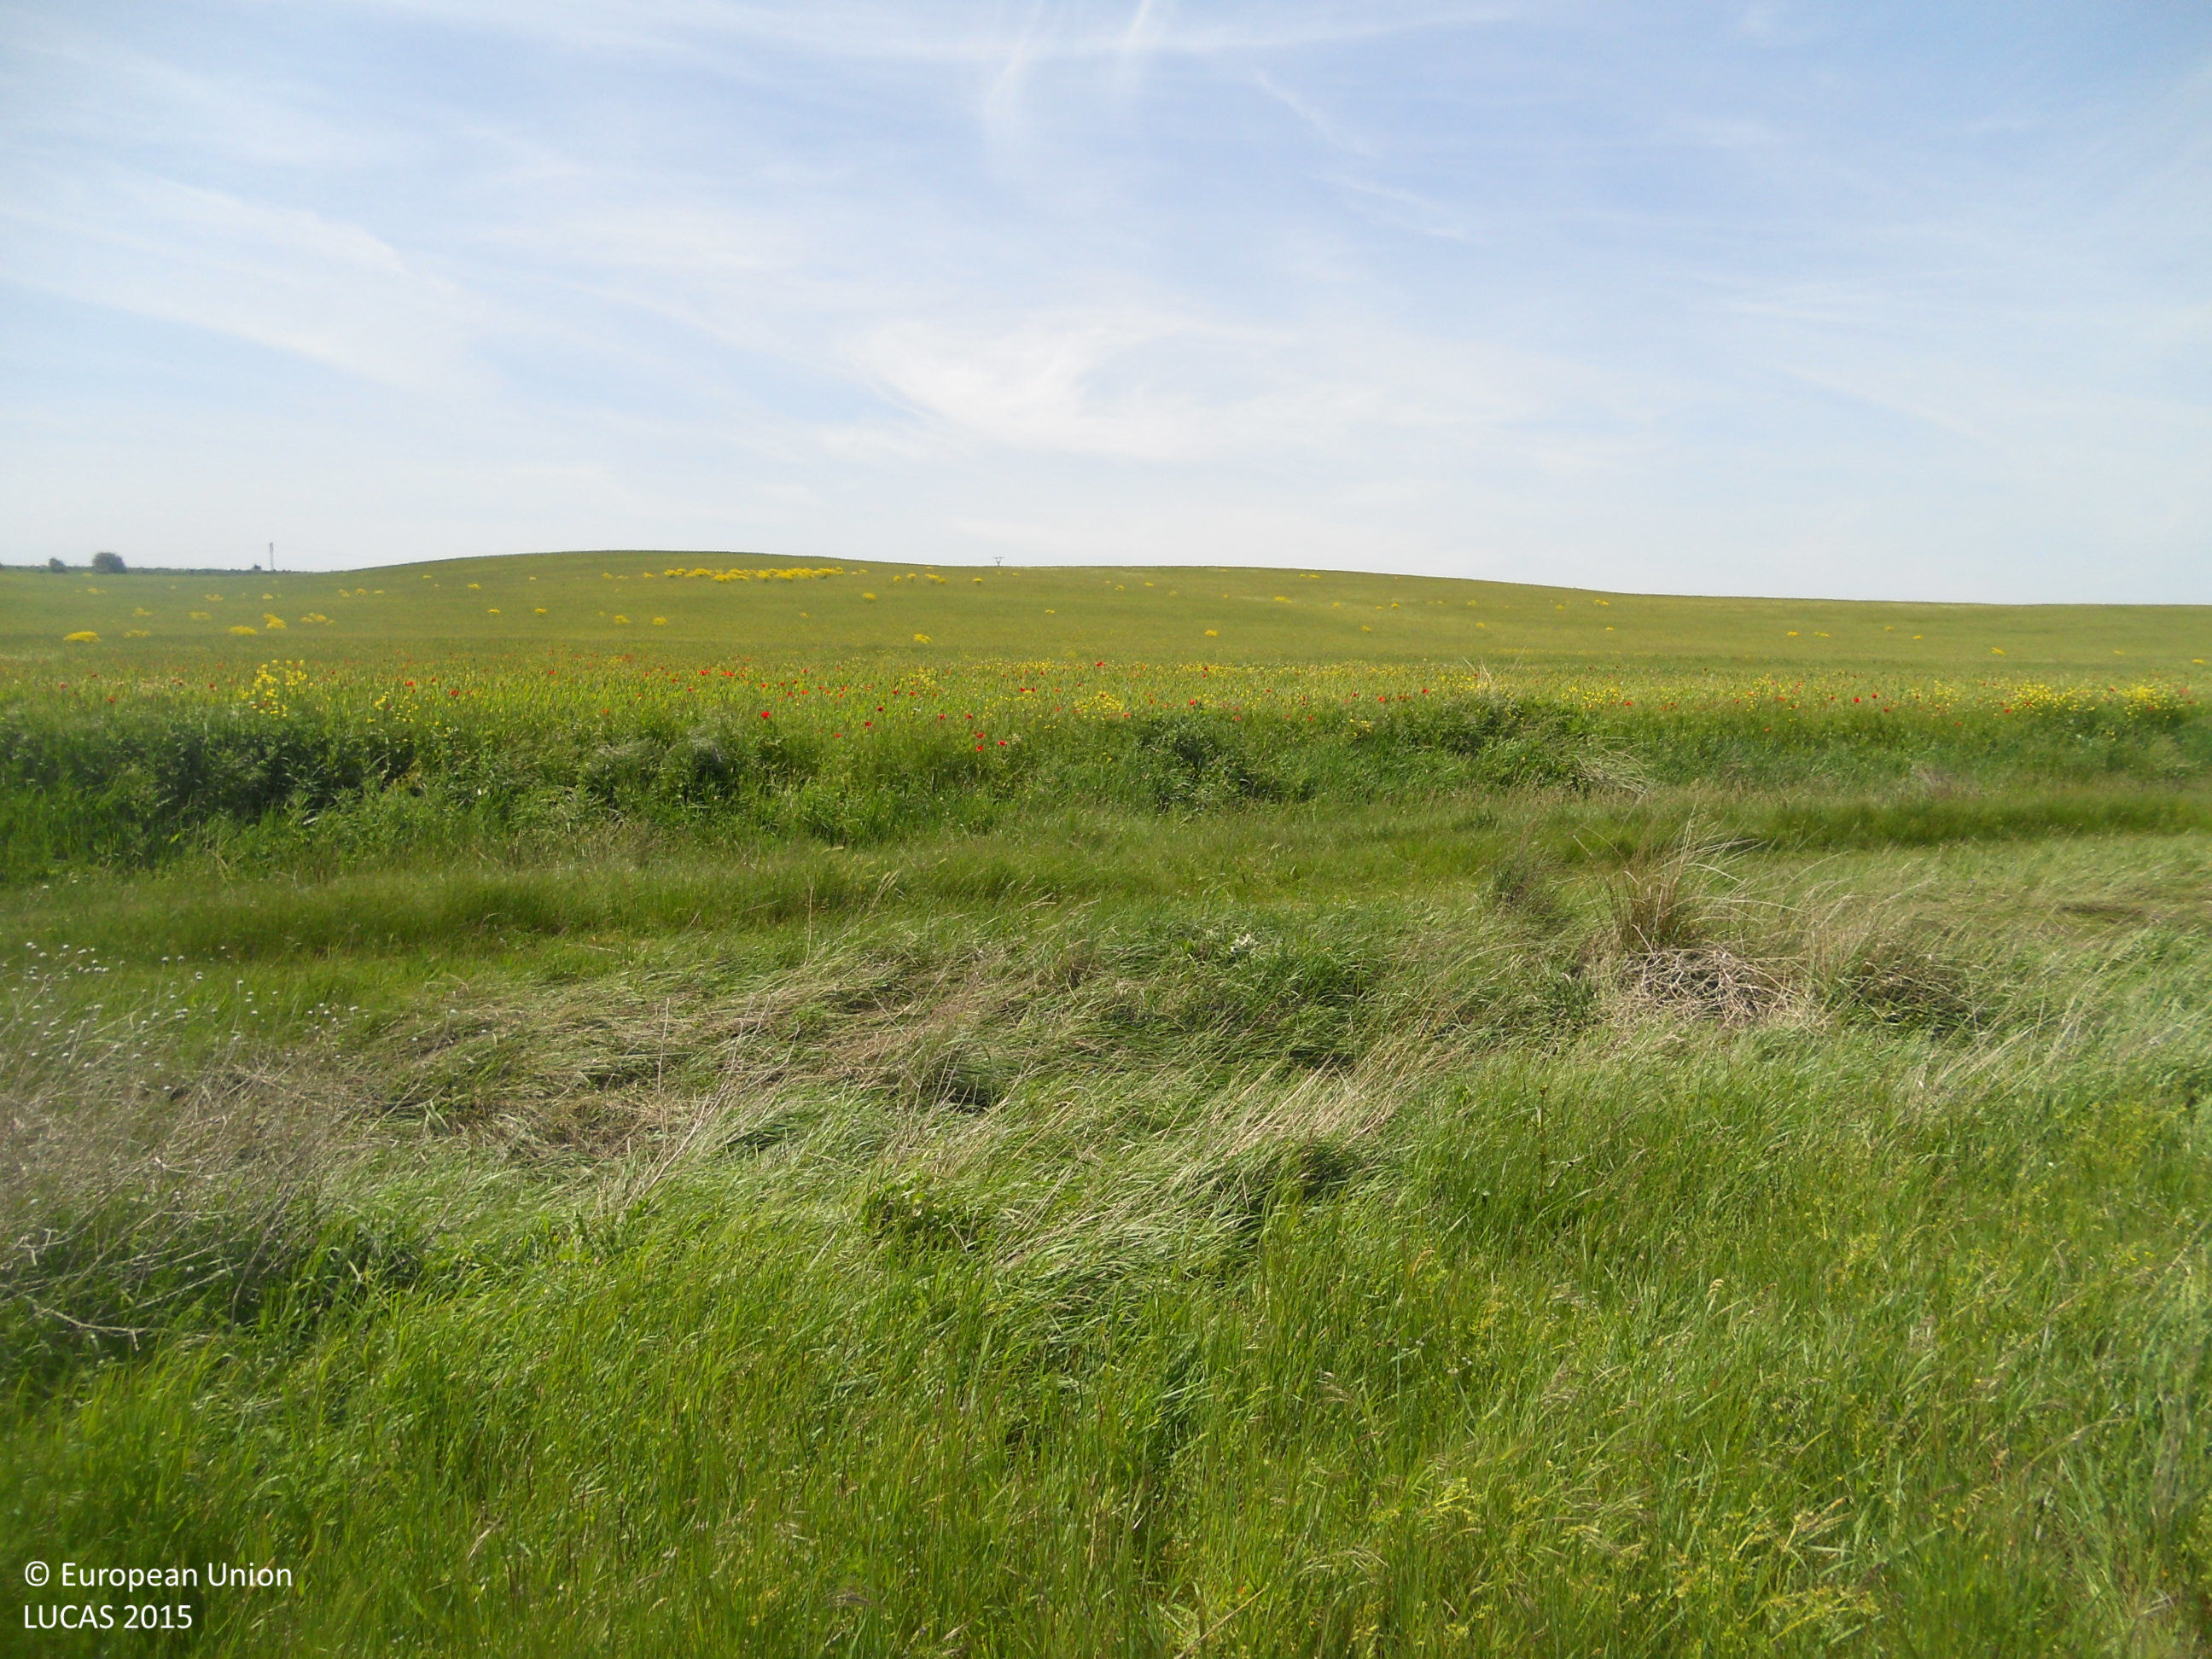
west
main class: Grassland
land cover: Grassland without tree/shrub cover
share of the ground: > 75 %
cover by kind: herbaceous plants 100 %
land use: Forestry
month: May
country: ES
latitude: 42.3462
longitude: -5.2984
